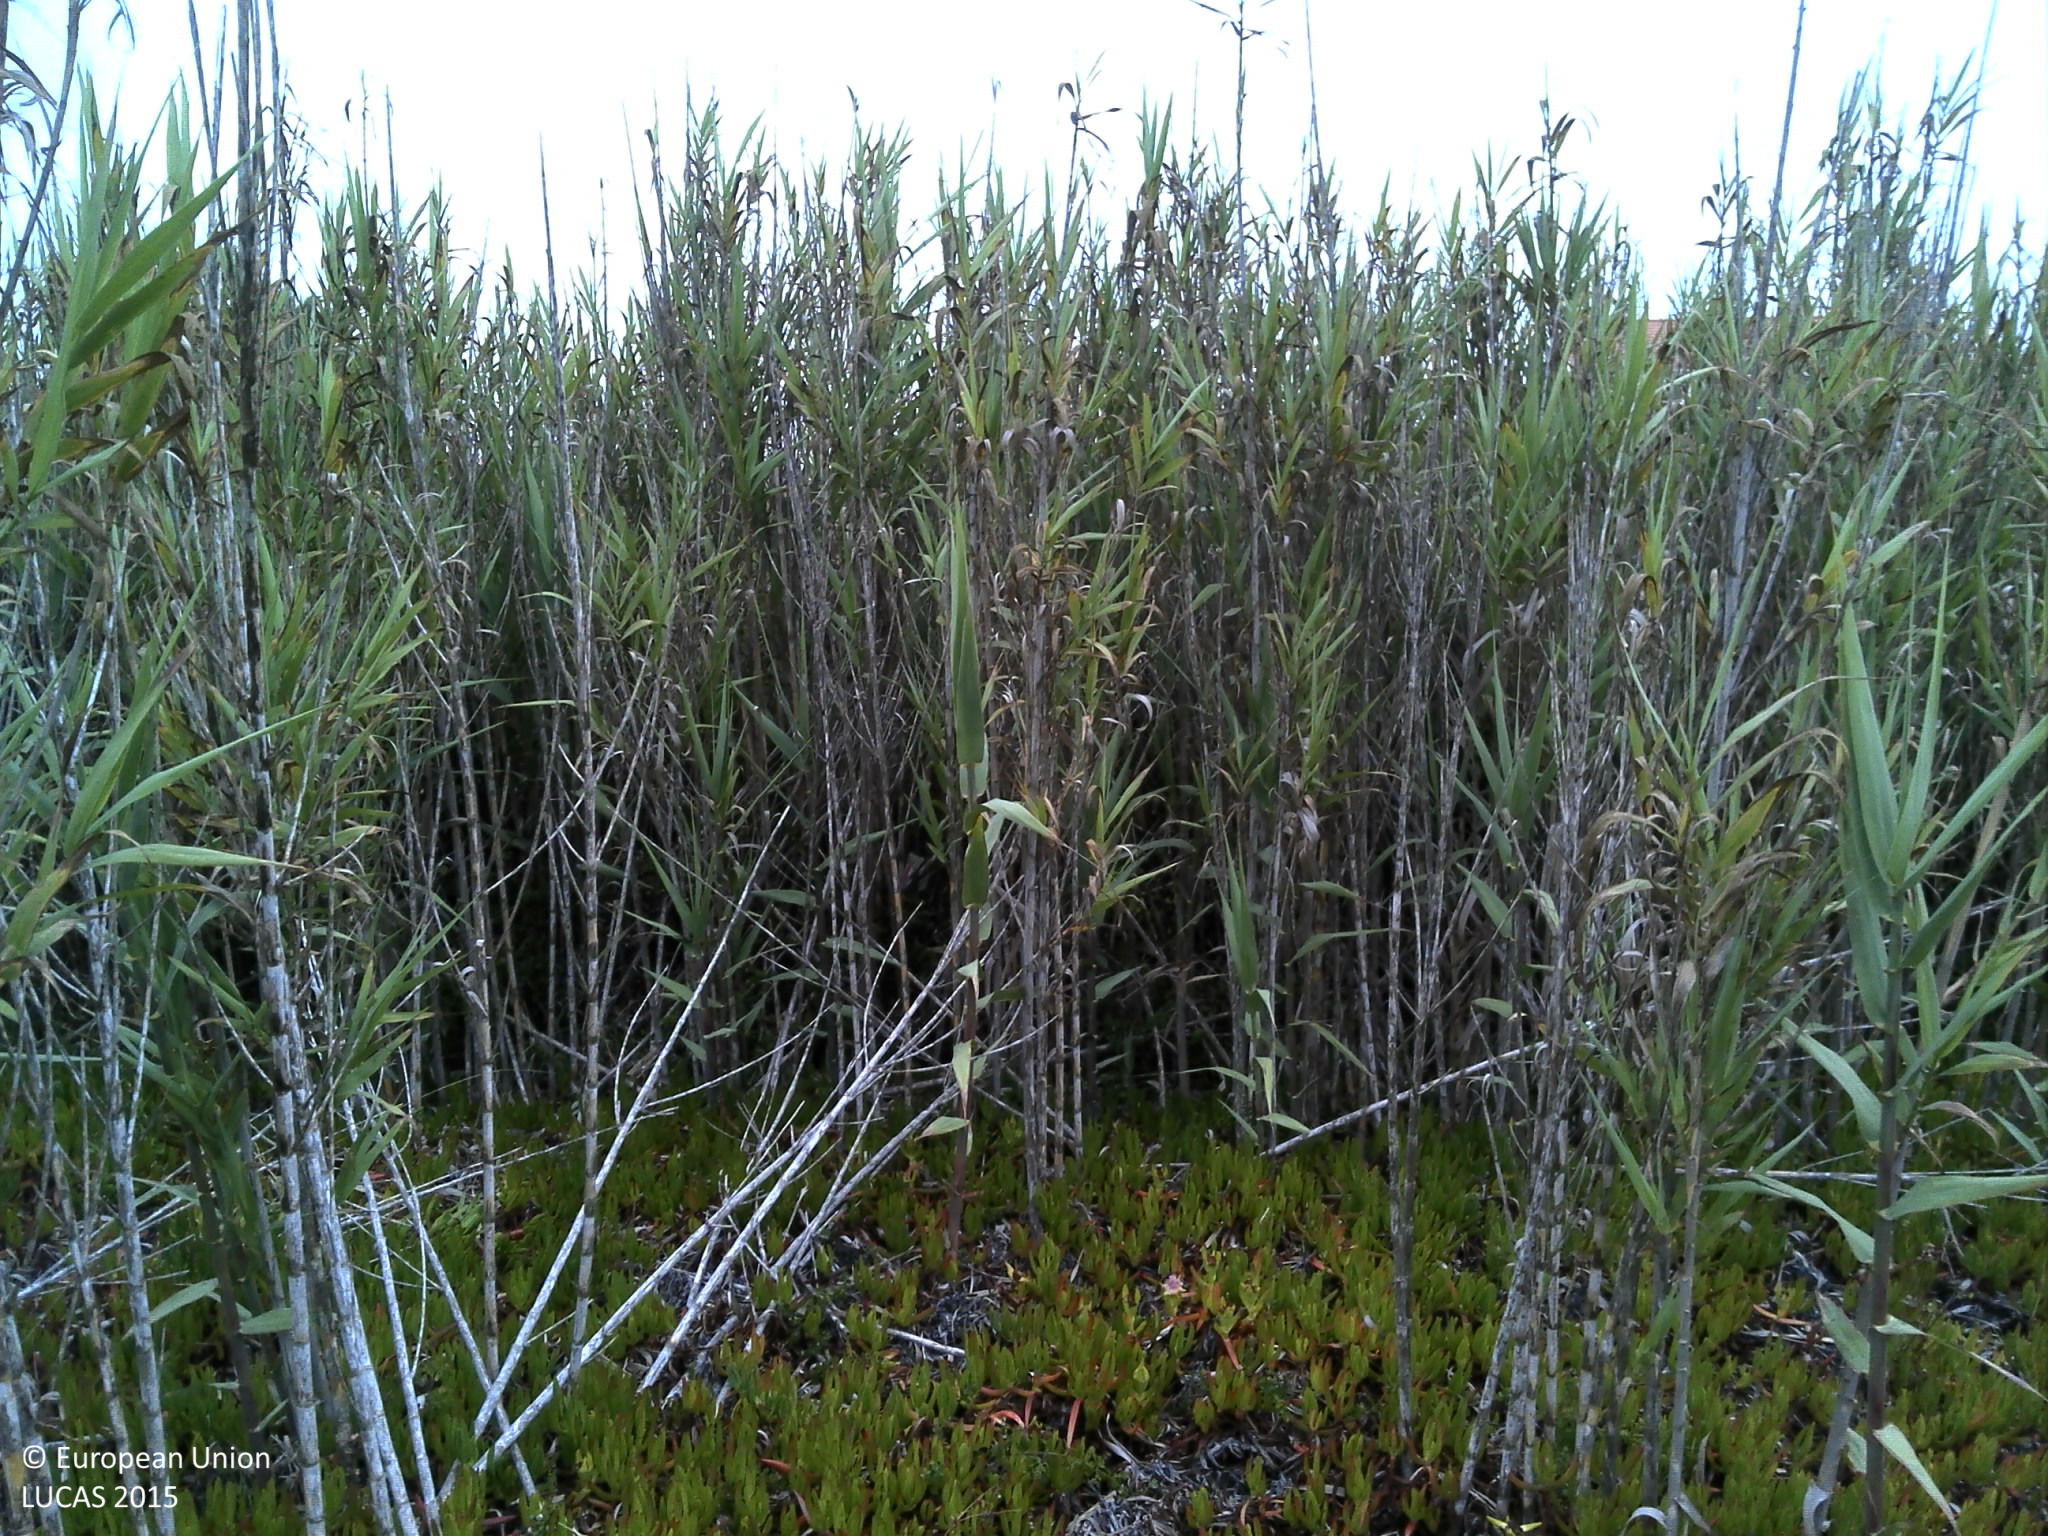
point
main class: Shrubland
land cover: Shrubland without tree cover
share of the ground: 50 - 75 %
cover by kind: shrubs 75 %, herbaceous plants 15 %, unconsolidated bare surface 10 %
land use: Semi-natural and natural areas not in use
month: June
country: PT
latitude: 39.3671
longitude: -9.3983
